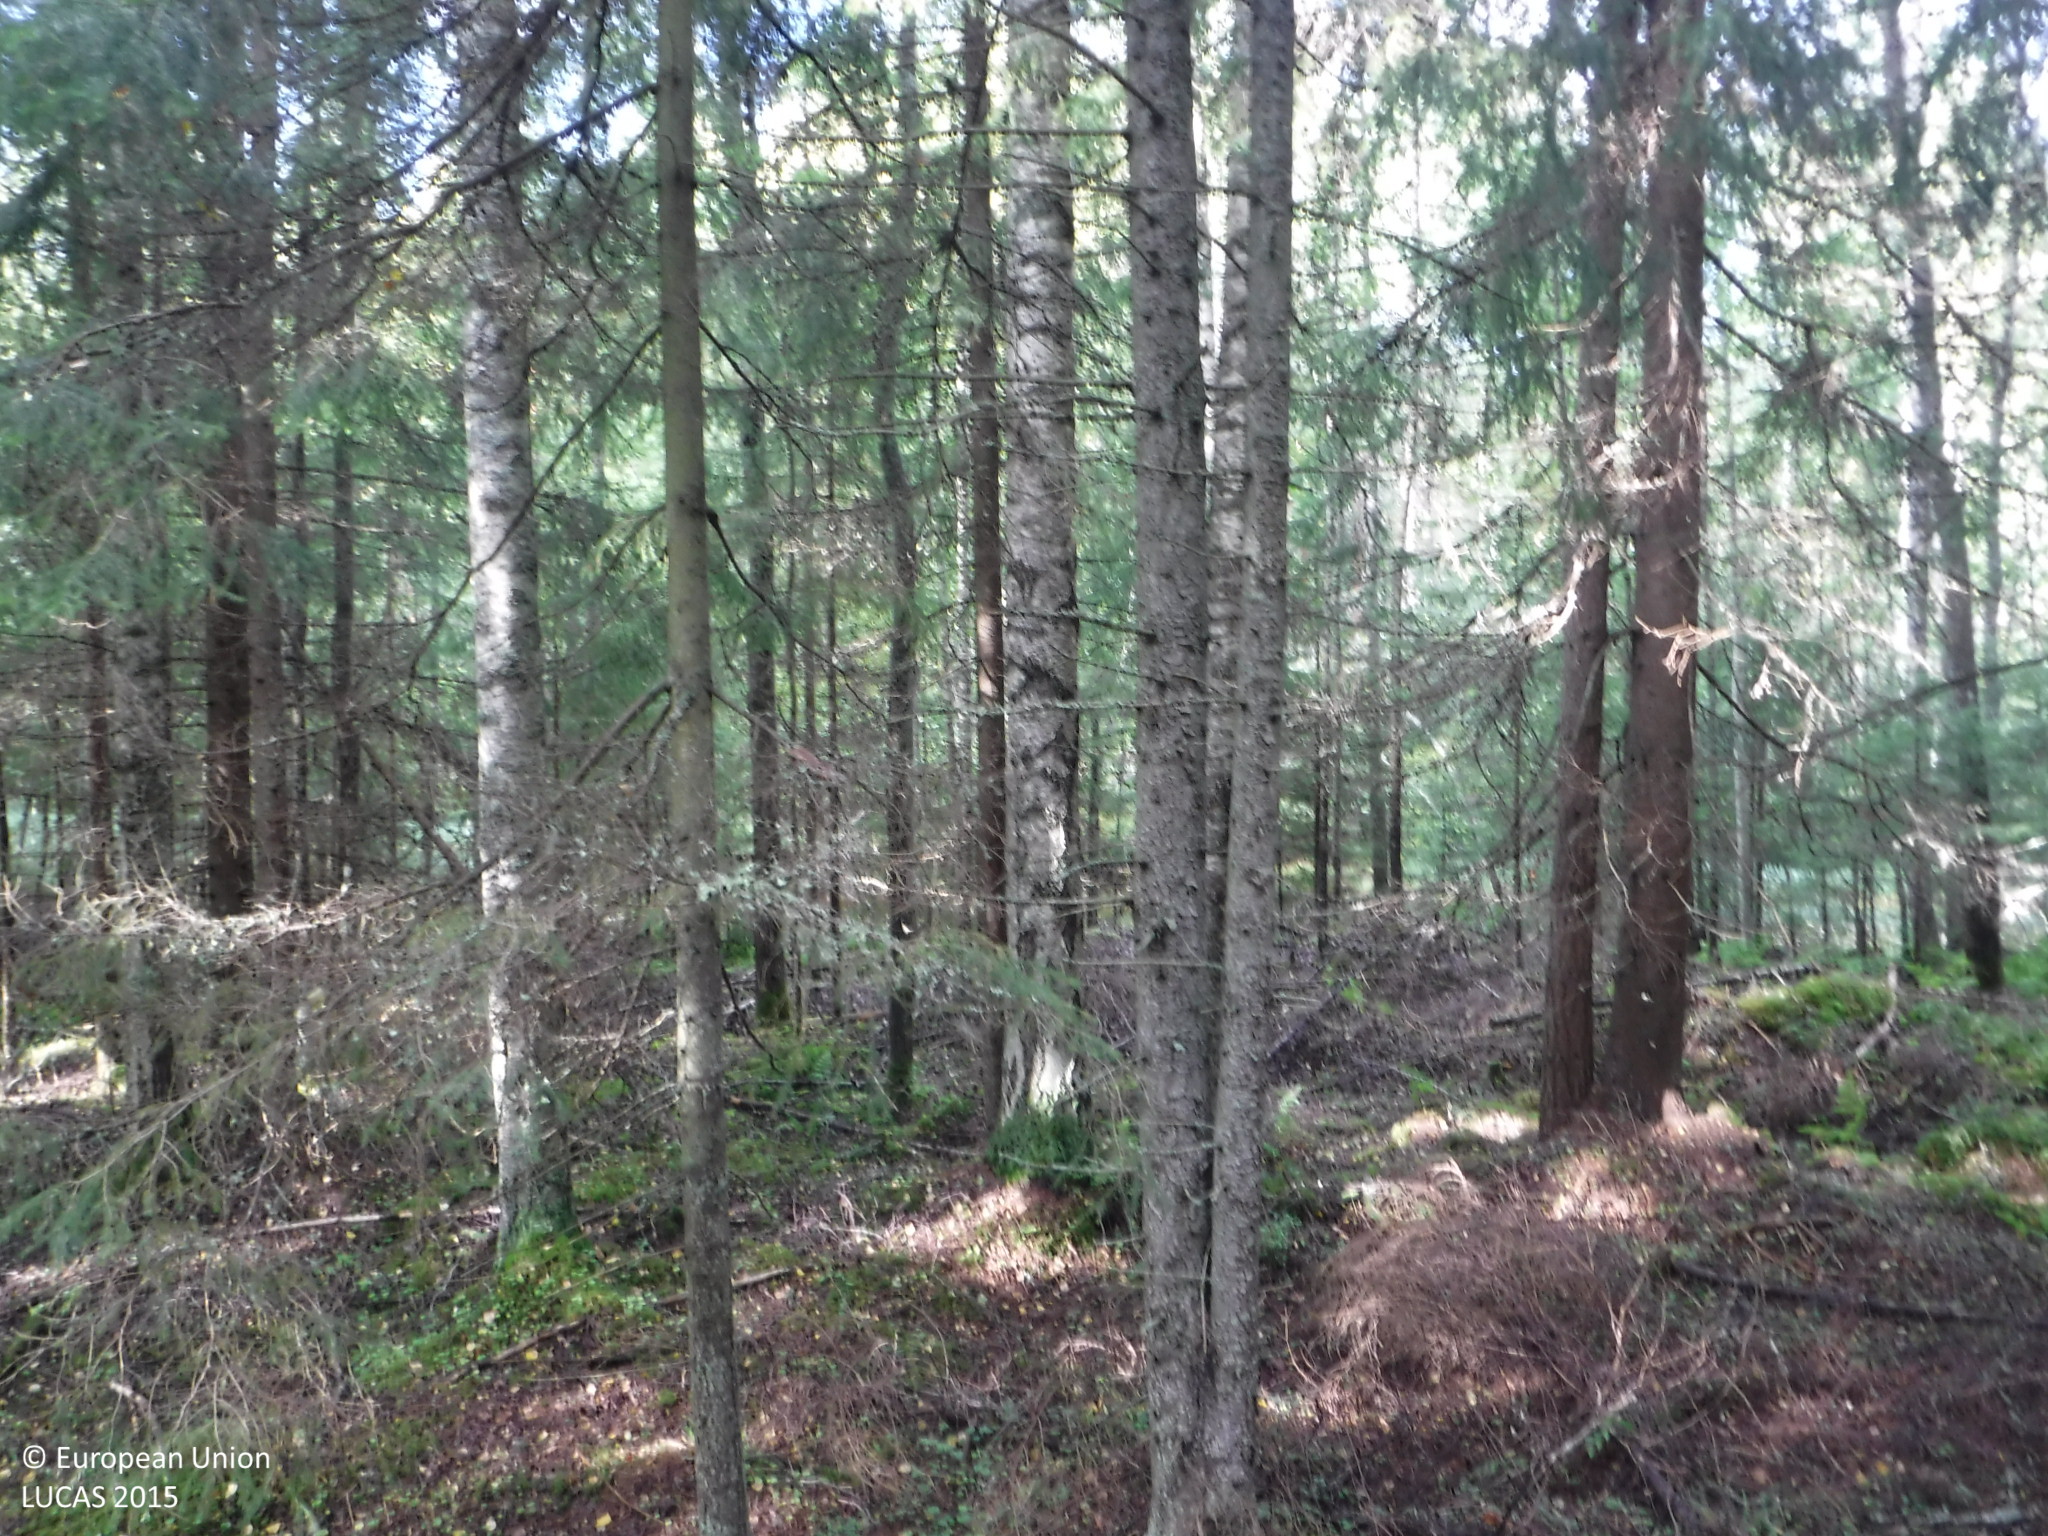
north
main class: Woodland
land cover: Other mixed woodland
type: boreal forest
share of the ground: > 75 %
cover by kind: coniferous forest trees 50 %, broadleaved forest trees 25 %, lichens and mosses 15 %, shrubs 10 %
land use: Forestry
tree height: > 5 m
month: September
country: FI
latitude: 61.4004
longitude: 23.0503
